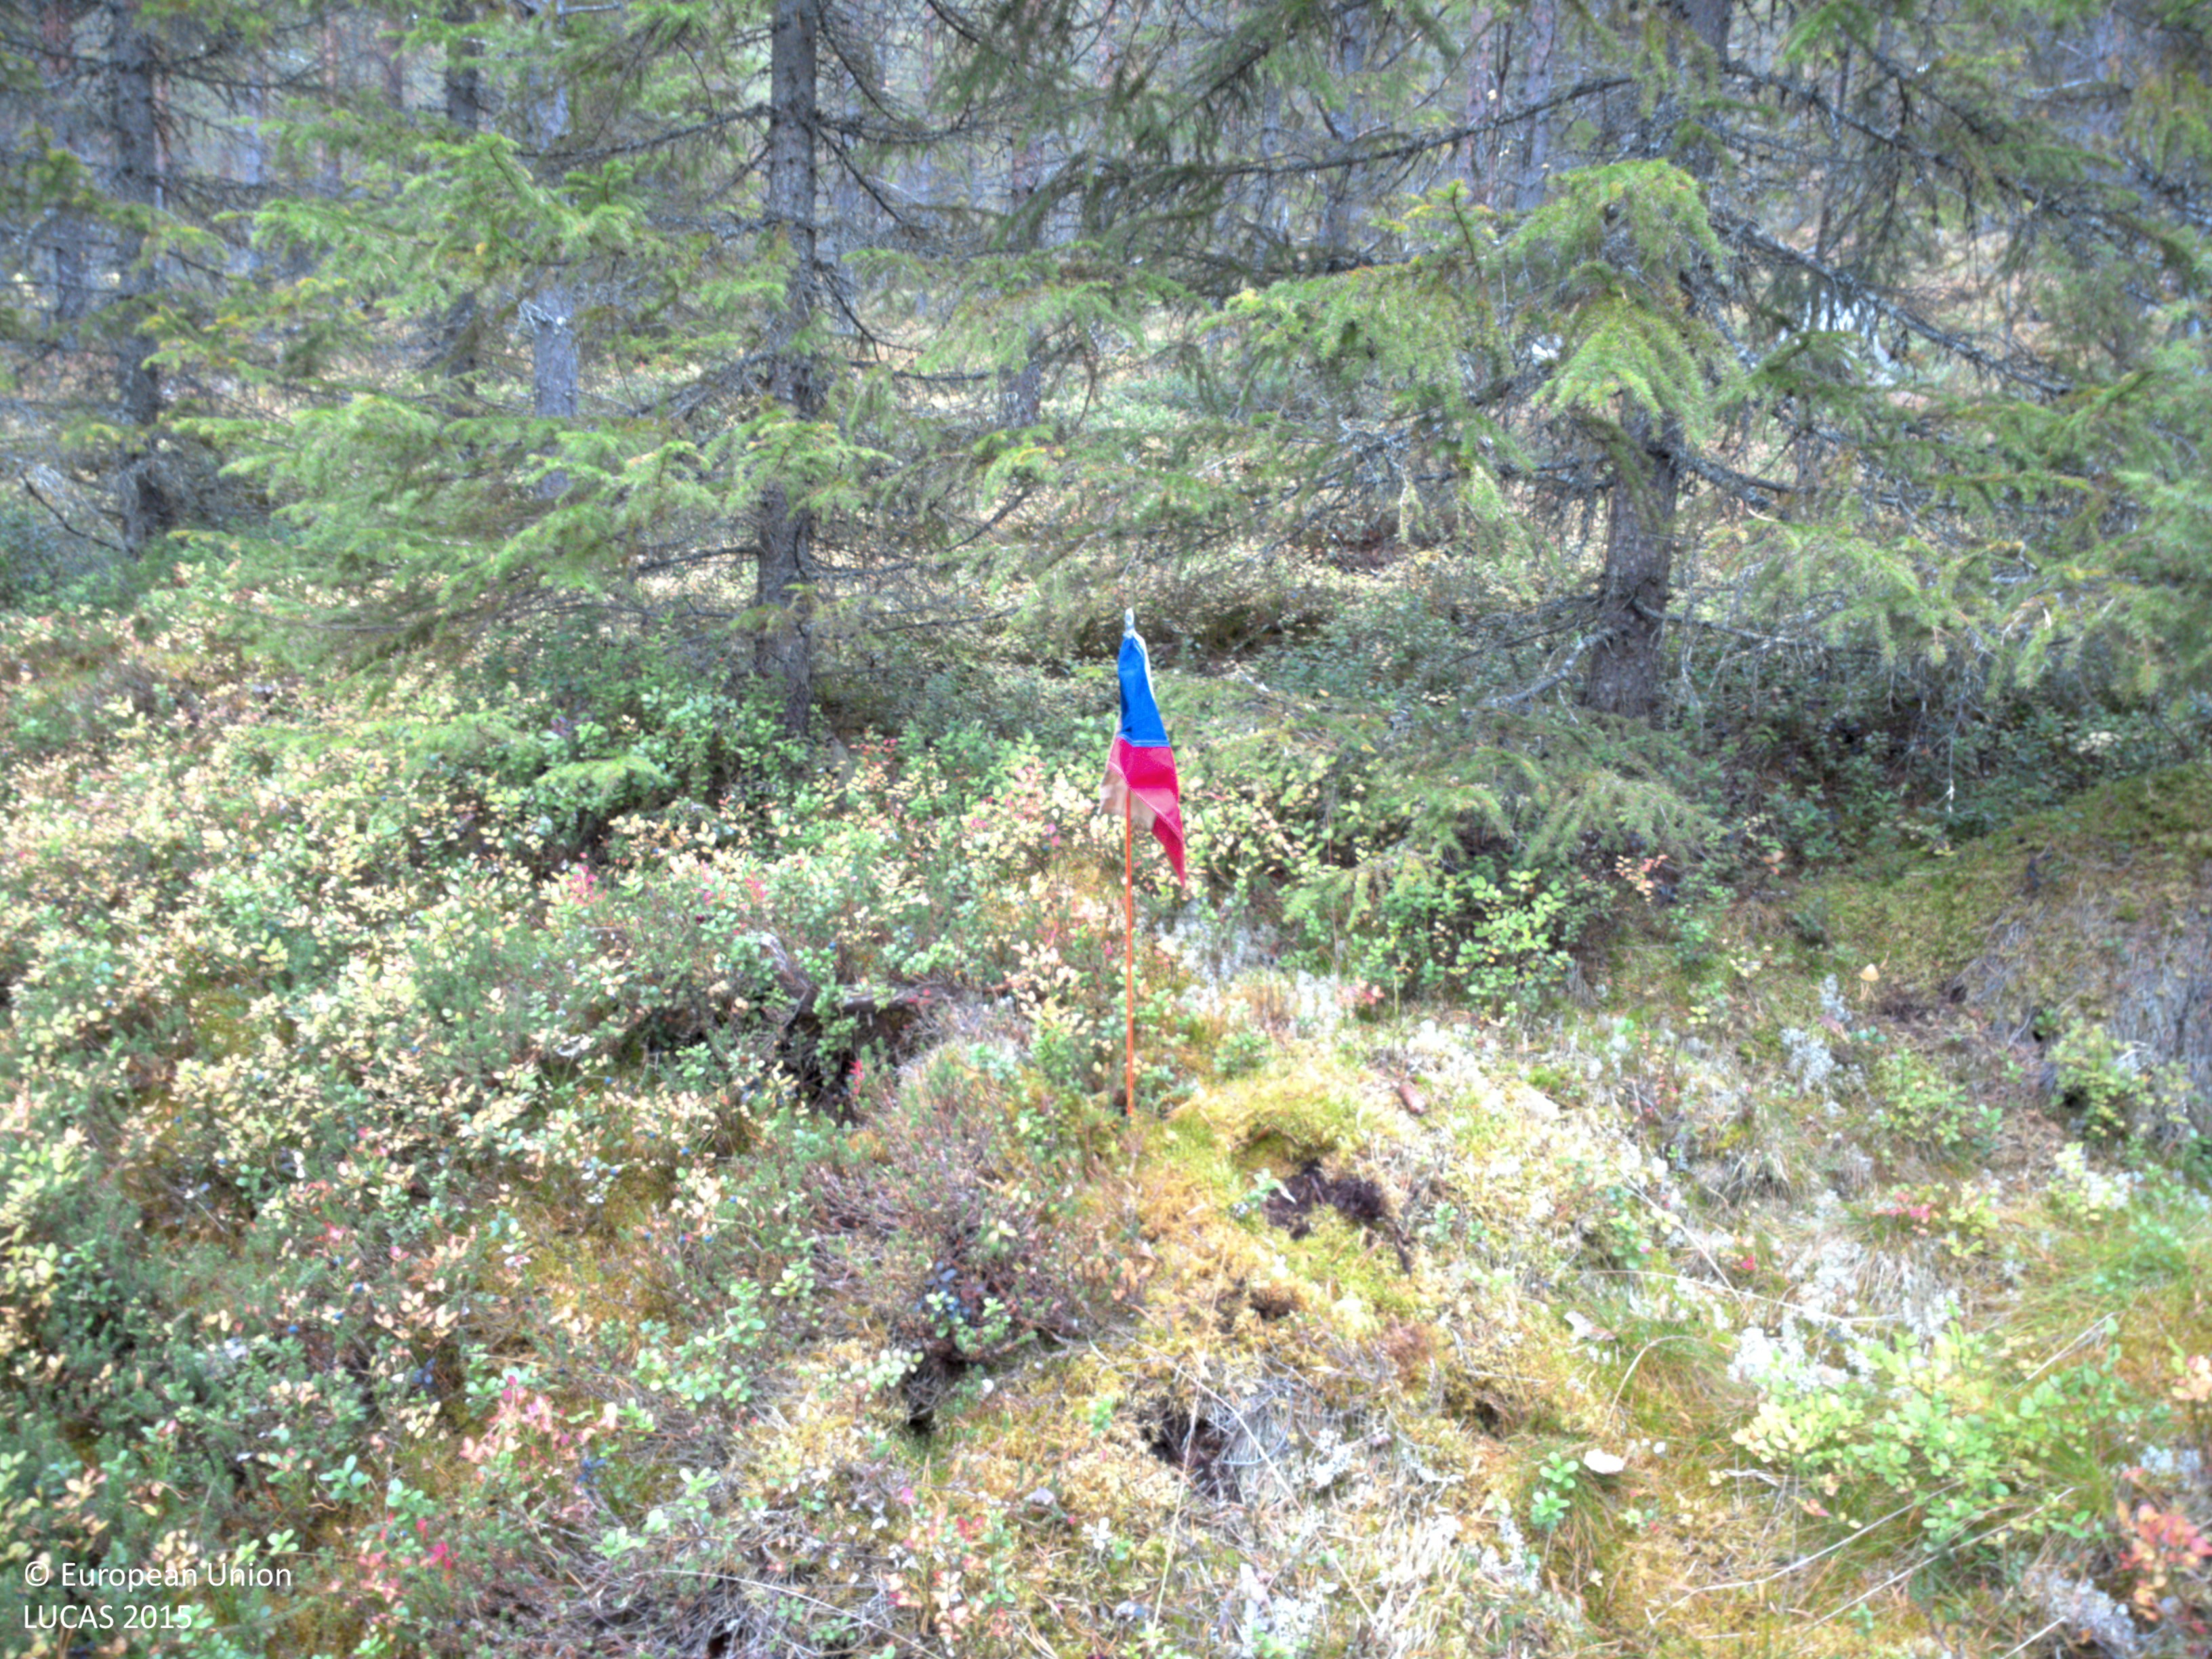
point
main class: Woodland
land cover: Other coniferous woodland
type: boreal forest
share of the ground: > 75 %
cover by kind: coniferous forest trees 80 %, shrubs 10 %, lichens and mosses 10 %
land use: Forestry
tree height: > 5 m
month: October
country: SE
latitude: 64.9536
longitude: 18.1146
